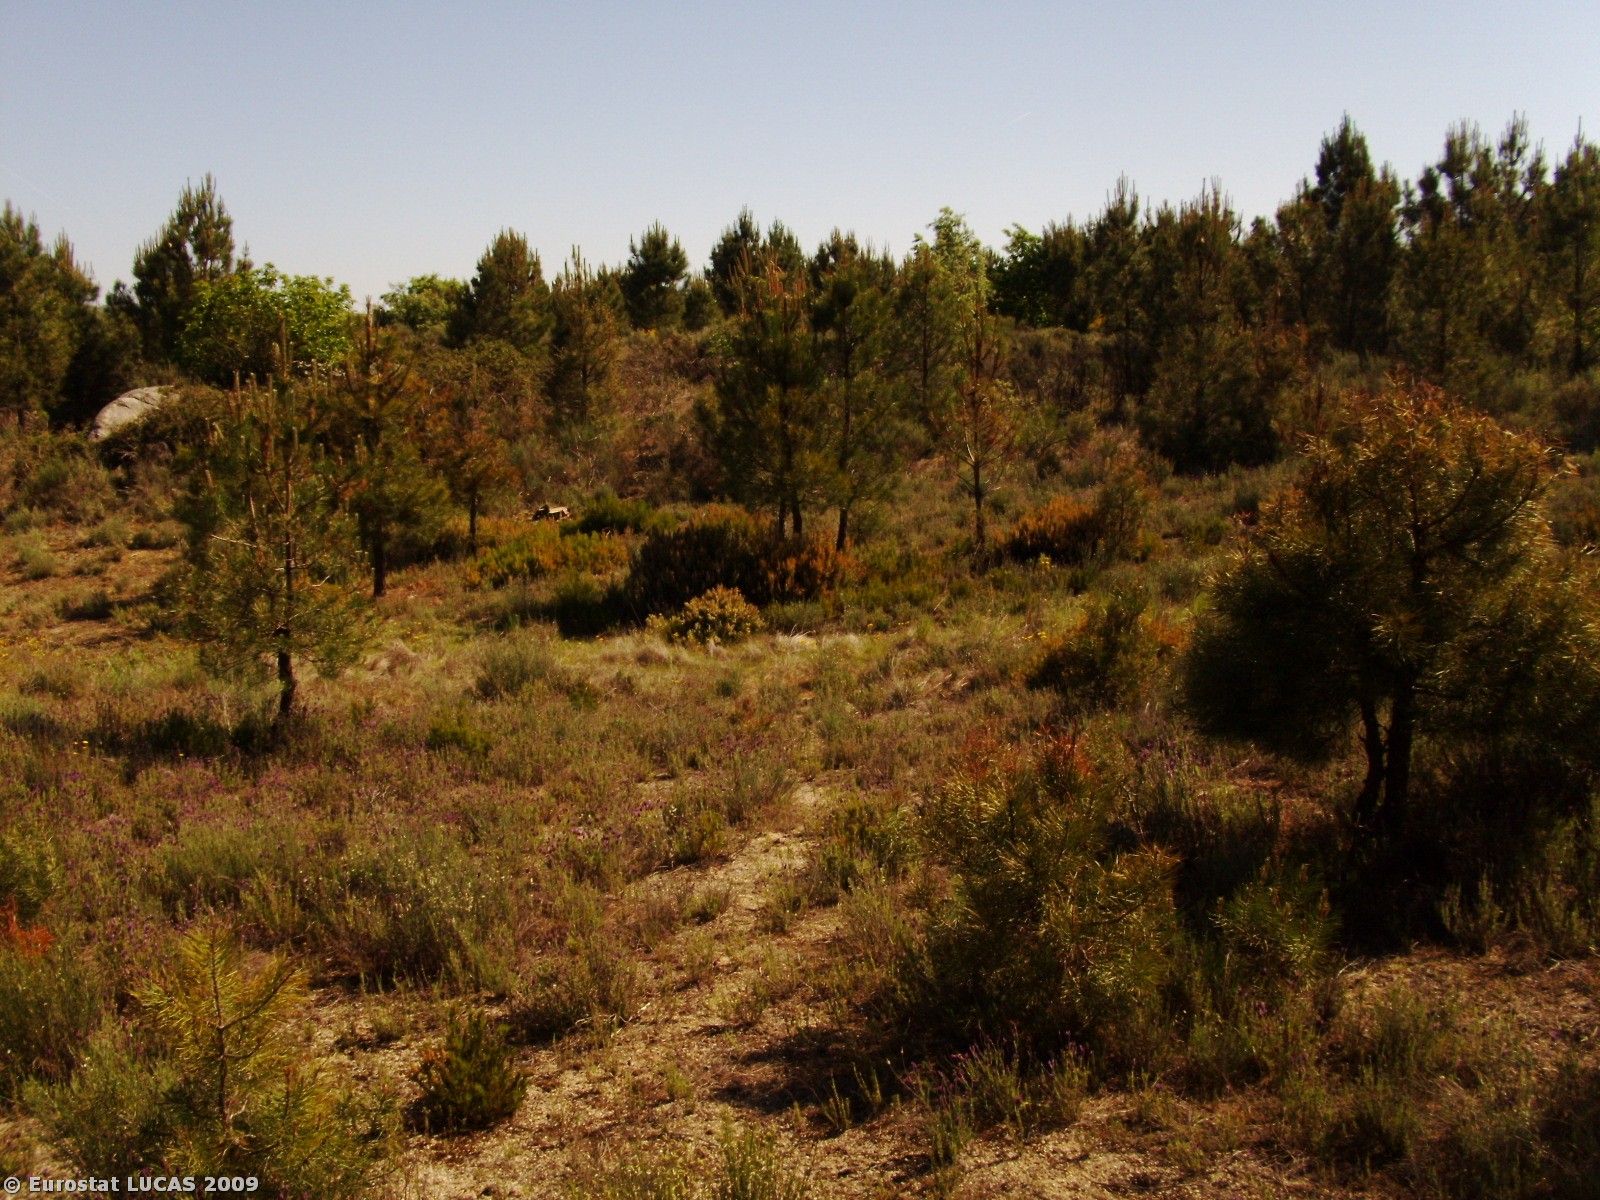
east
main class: Woodland
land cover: Coniferous woodland
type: coniferous forest of the mediterranean region
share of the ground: 25 - 50 %
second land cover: Shrubland with sparse tree cover
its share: 50 - 75 %
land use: Forestry
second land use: Fallow land
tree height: > 5 m
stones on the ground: 25 - 50 %
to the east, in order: Coniferous woodland; Shrubland with sparse tree cover; Coniferous woodland; Dry stone walls; Tracks; Grass margins; Bare land; Single bushes/trees; Bare land; Spontaneously vegetated surfaces
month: May
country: PT
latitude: 40.9239
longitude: -7.4420
